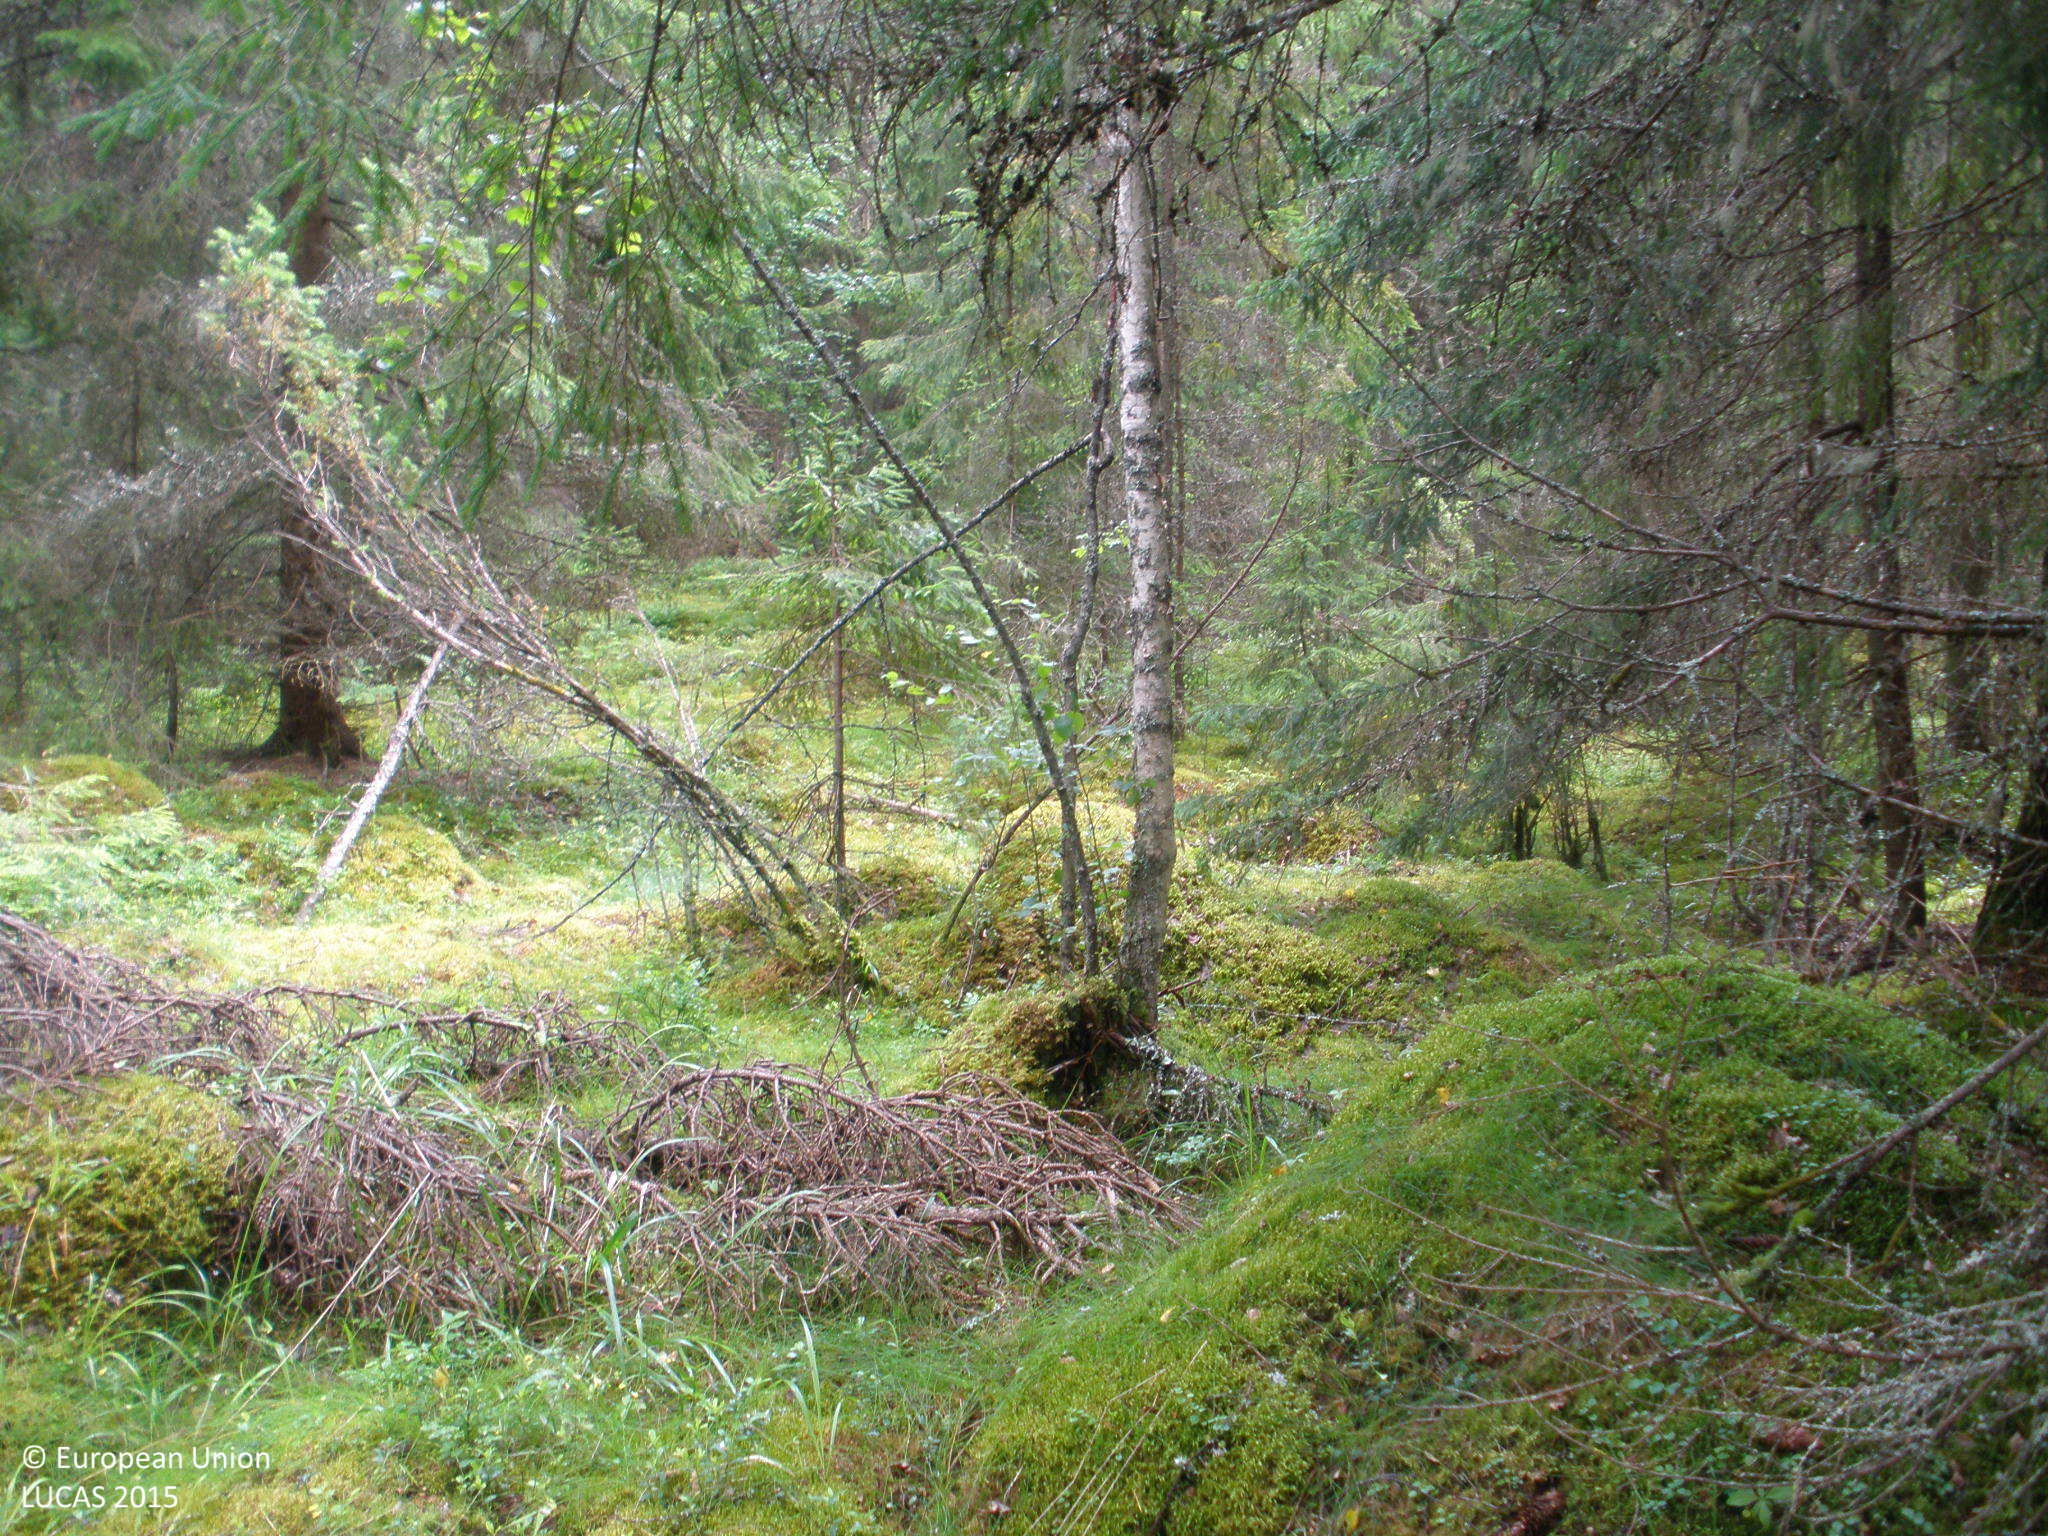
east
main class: Woodland
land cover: Spruce dominated coniferous woodland
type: boreal forest
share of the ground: > 75 %
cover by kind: coniferous forest trees 80 %, lichens and mosses 10 %, broadleaved forest trees 5 %, herbaceous plants 5 %
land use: Forestry
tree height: > 5 m
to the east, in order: Spruce dominated coniferous woodland; Pine dominated coniferous woodland; Ditches and canals; Pine dominated coniferous woodland; Ditches and canals; Spruce dominated mixed woodland; Spruce dominated coniferous woodland
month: July
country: FI
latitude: 60.9902
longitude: 24.9940
